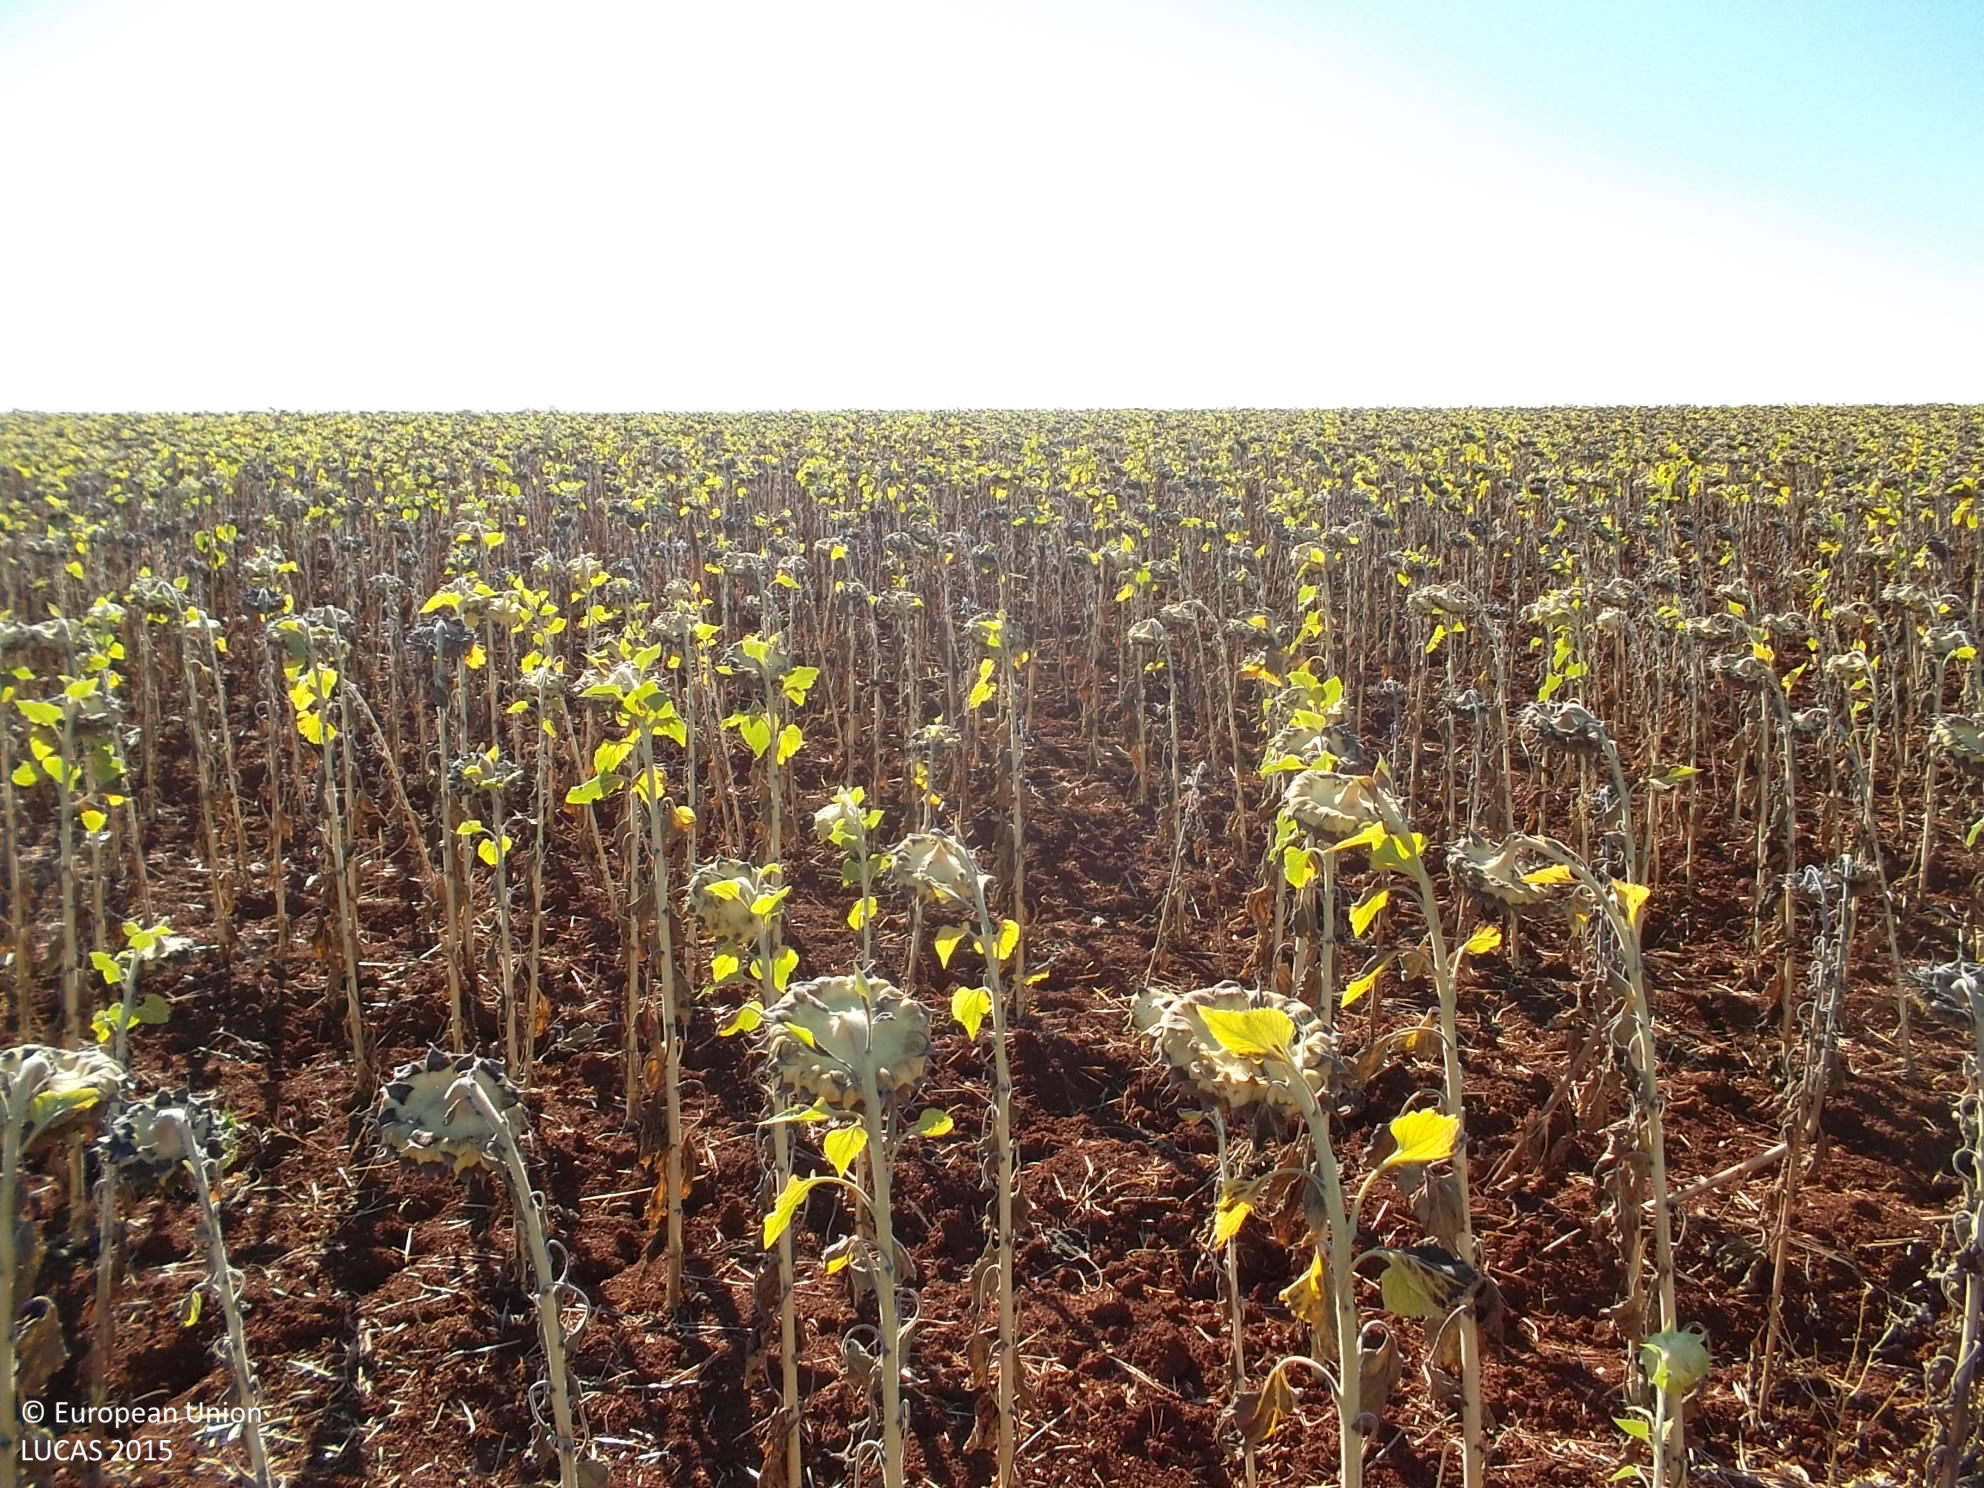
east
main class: Cropland
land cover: Sunflower
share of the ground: > 75 %
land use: Agriculture (excluding fallow land and kitchen gardens)
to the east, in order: Sunflower
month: July
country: ES
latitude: 38.3744
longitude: -5.7769
